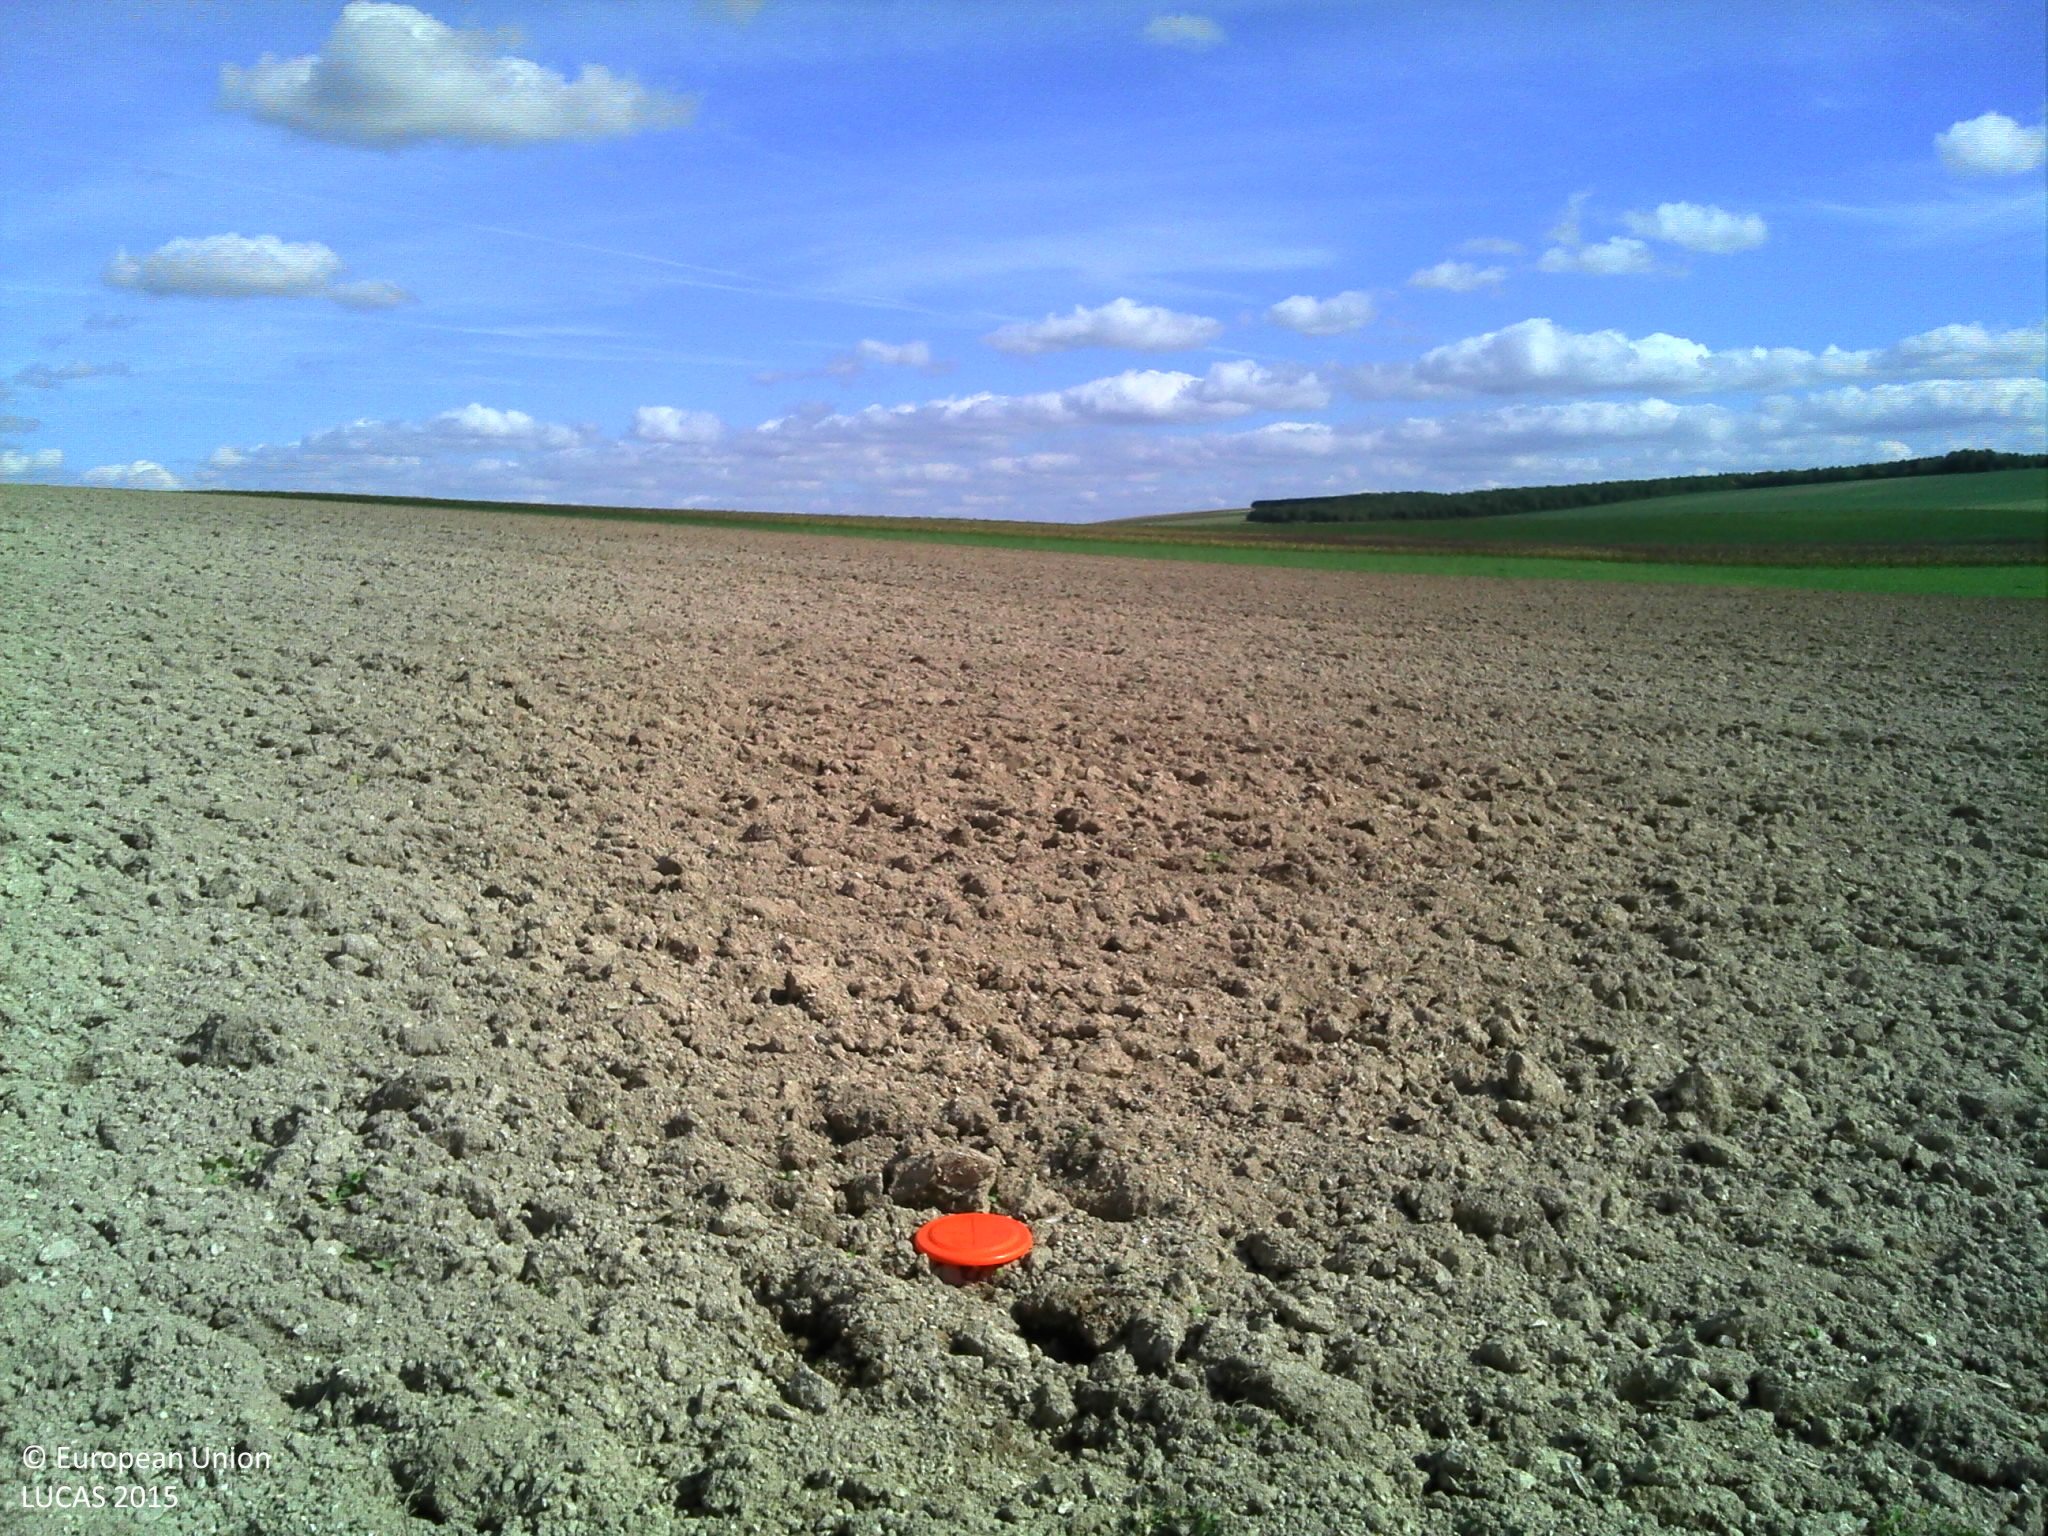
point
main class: Cropland
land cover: Rape and turnip rape
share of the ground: < 10 %
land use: Agriculture (excluding fallow land and kitchen gardens)
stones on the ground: < 10 %
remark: Tilled/Sowed
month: September
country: FR
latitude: 48.3036
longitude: 3.8344
